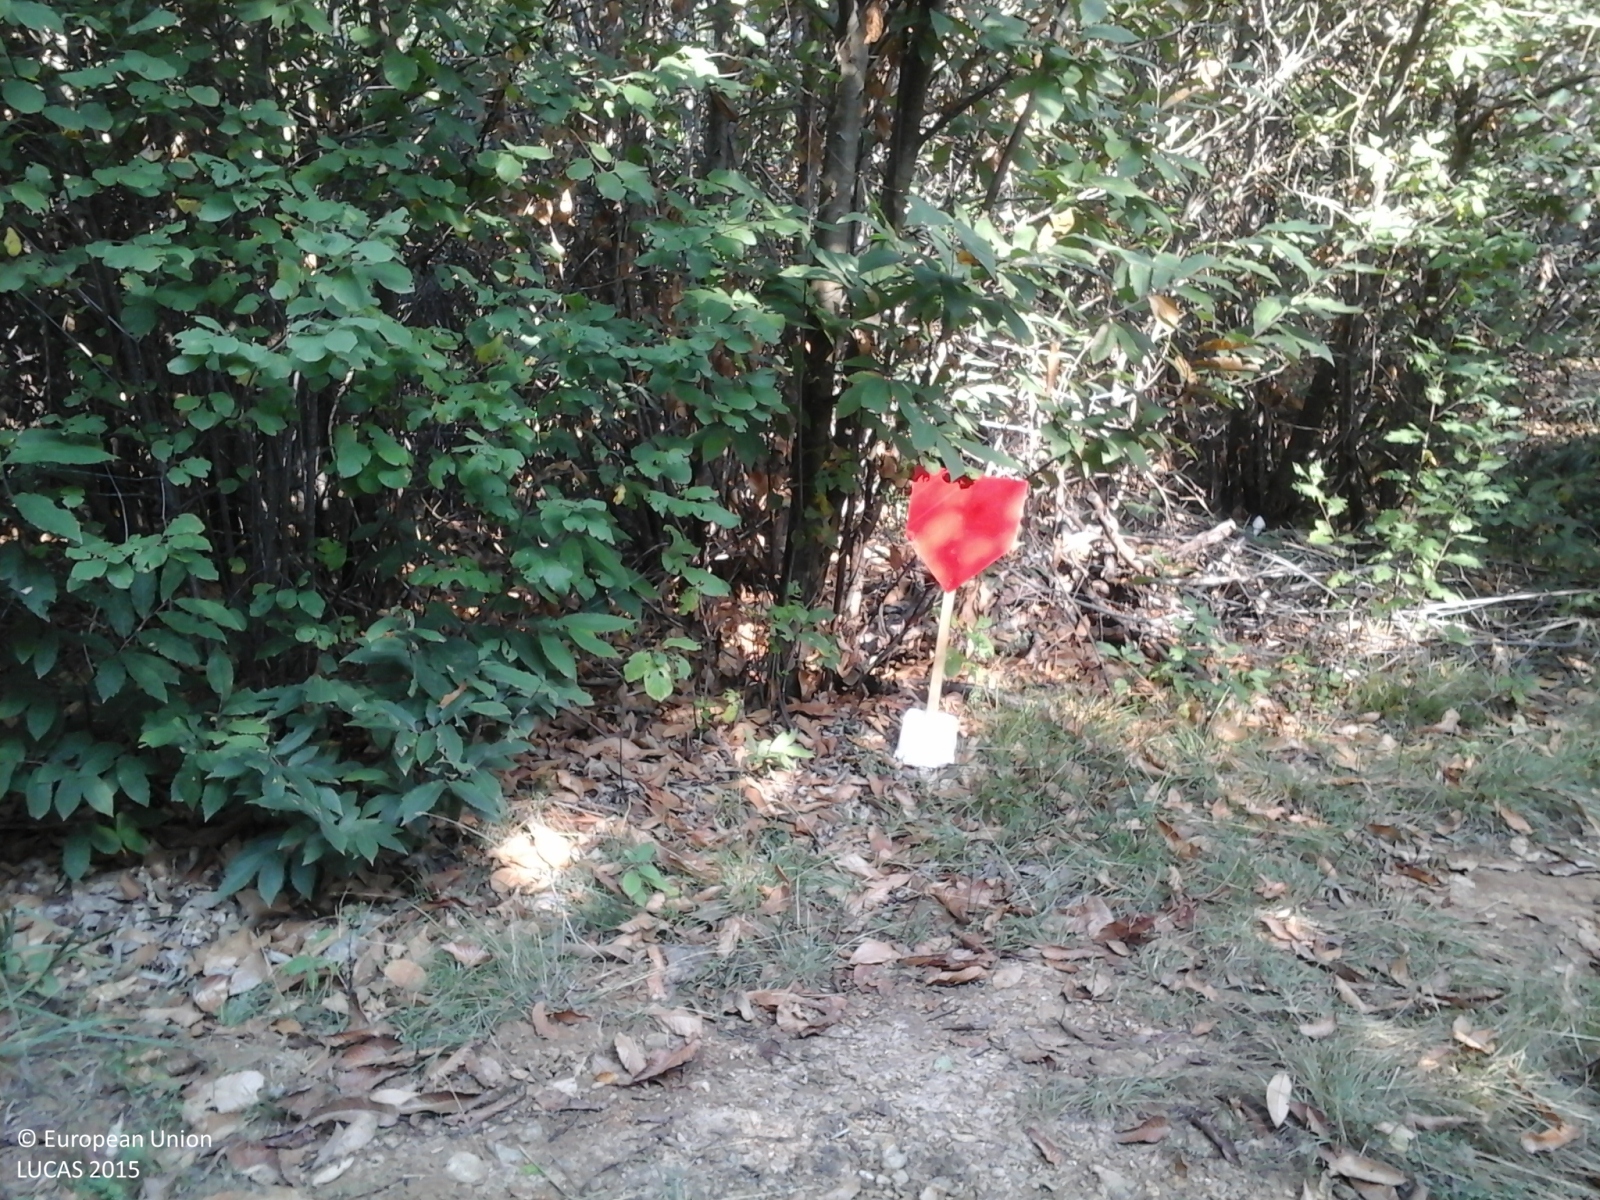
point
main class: Woodland
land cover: Broadleaved woodland
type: thermophilous deciduous forest
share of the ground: > 75 %
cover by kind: broadleaved forest trees 90 %, shrubs 5 %, herbaceous plants 5 %
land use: Semi-natural and natural areas not in use
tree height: > 5 m
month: September
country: IT
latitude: 44.3729
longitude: 8.3095
